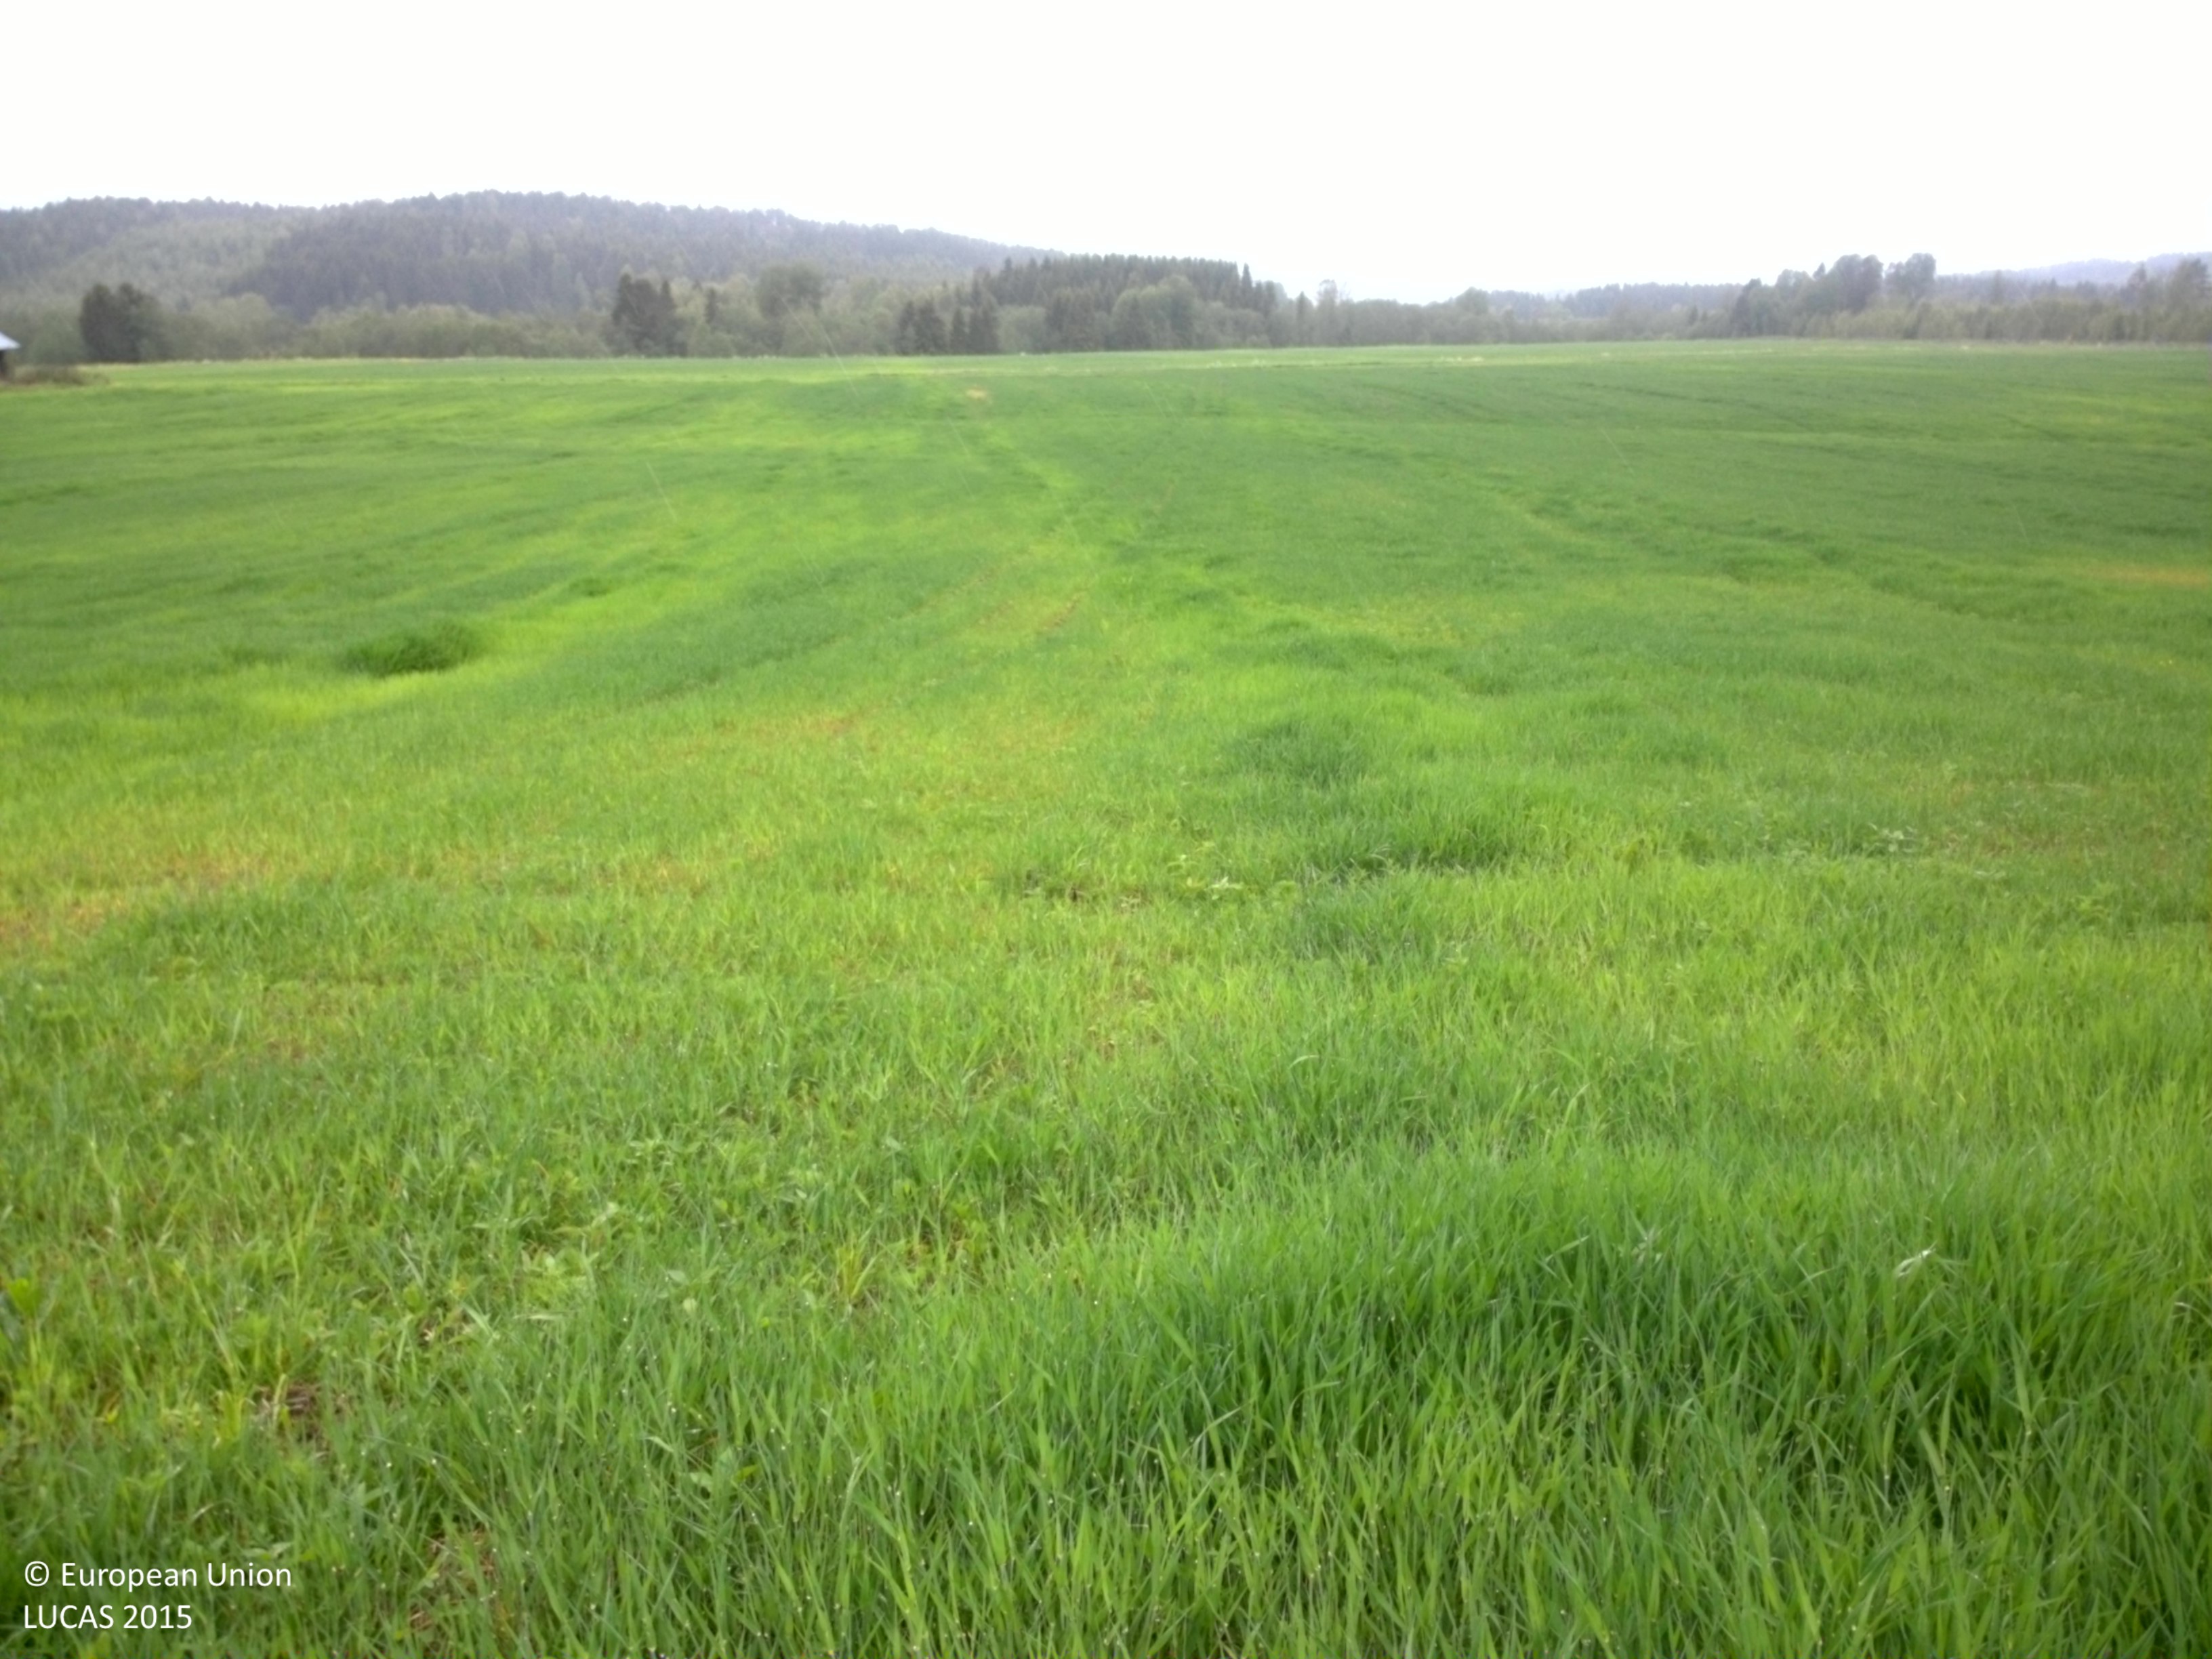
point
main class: Cropland
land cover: Barley
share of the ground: > 75 %
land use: Agriculture (excluding fallow land and kitchen gardens)
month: June
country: SE
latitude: 59.6782
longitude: 12.1429
